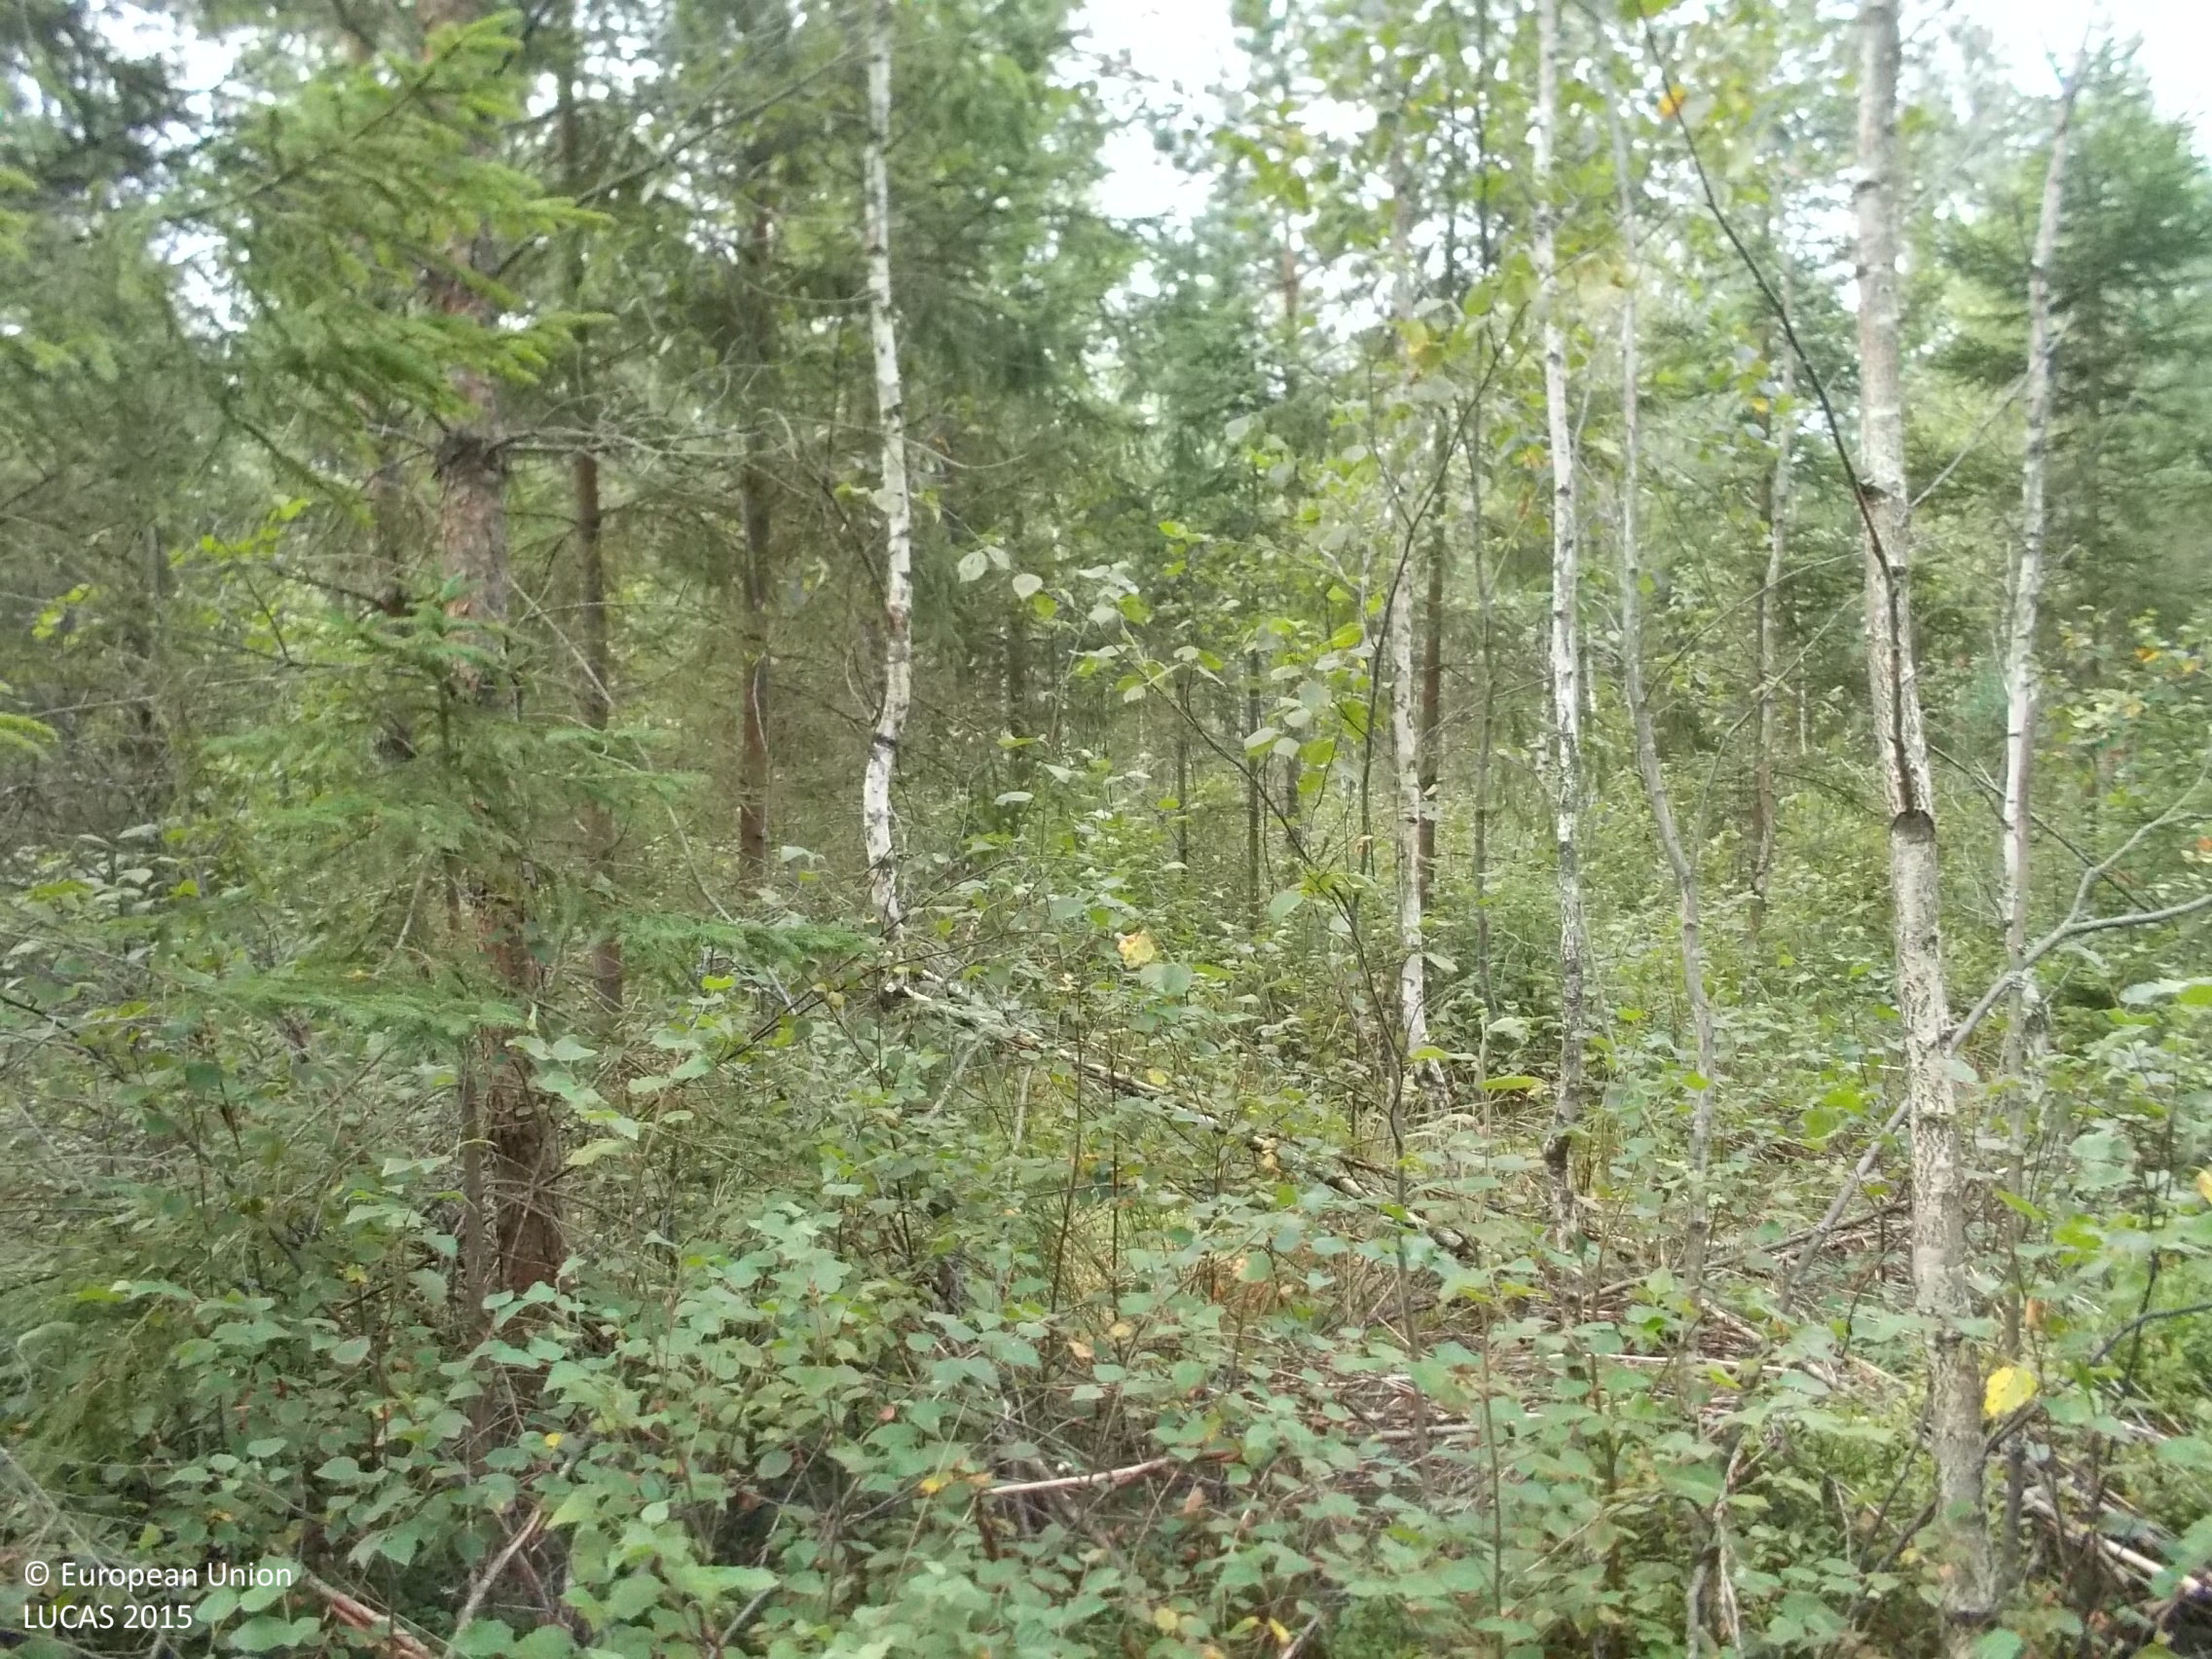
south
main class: Woodland
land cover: Spruce dominated mixed woodland
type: boreal forest
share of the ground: > 75 %
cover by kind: broadleaved forest trees 45 %, coniferous forest trees 40 %, shrubs 5 %, herbaceous plants 5 %, lichens and mosses 5 %
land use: Forestry
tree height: > 5 m
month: August
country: SE
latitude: 57.3893
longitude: 13.2068
